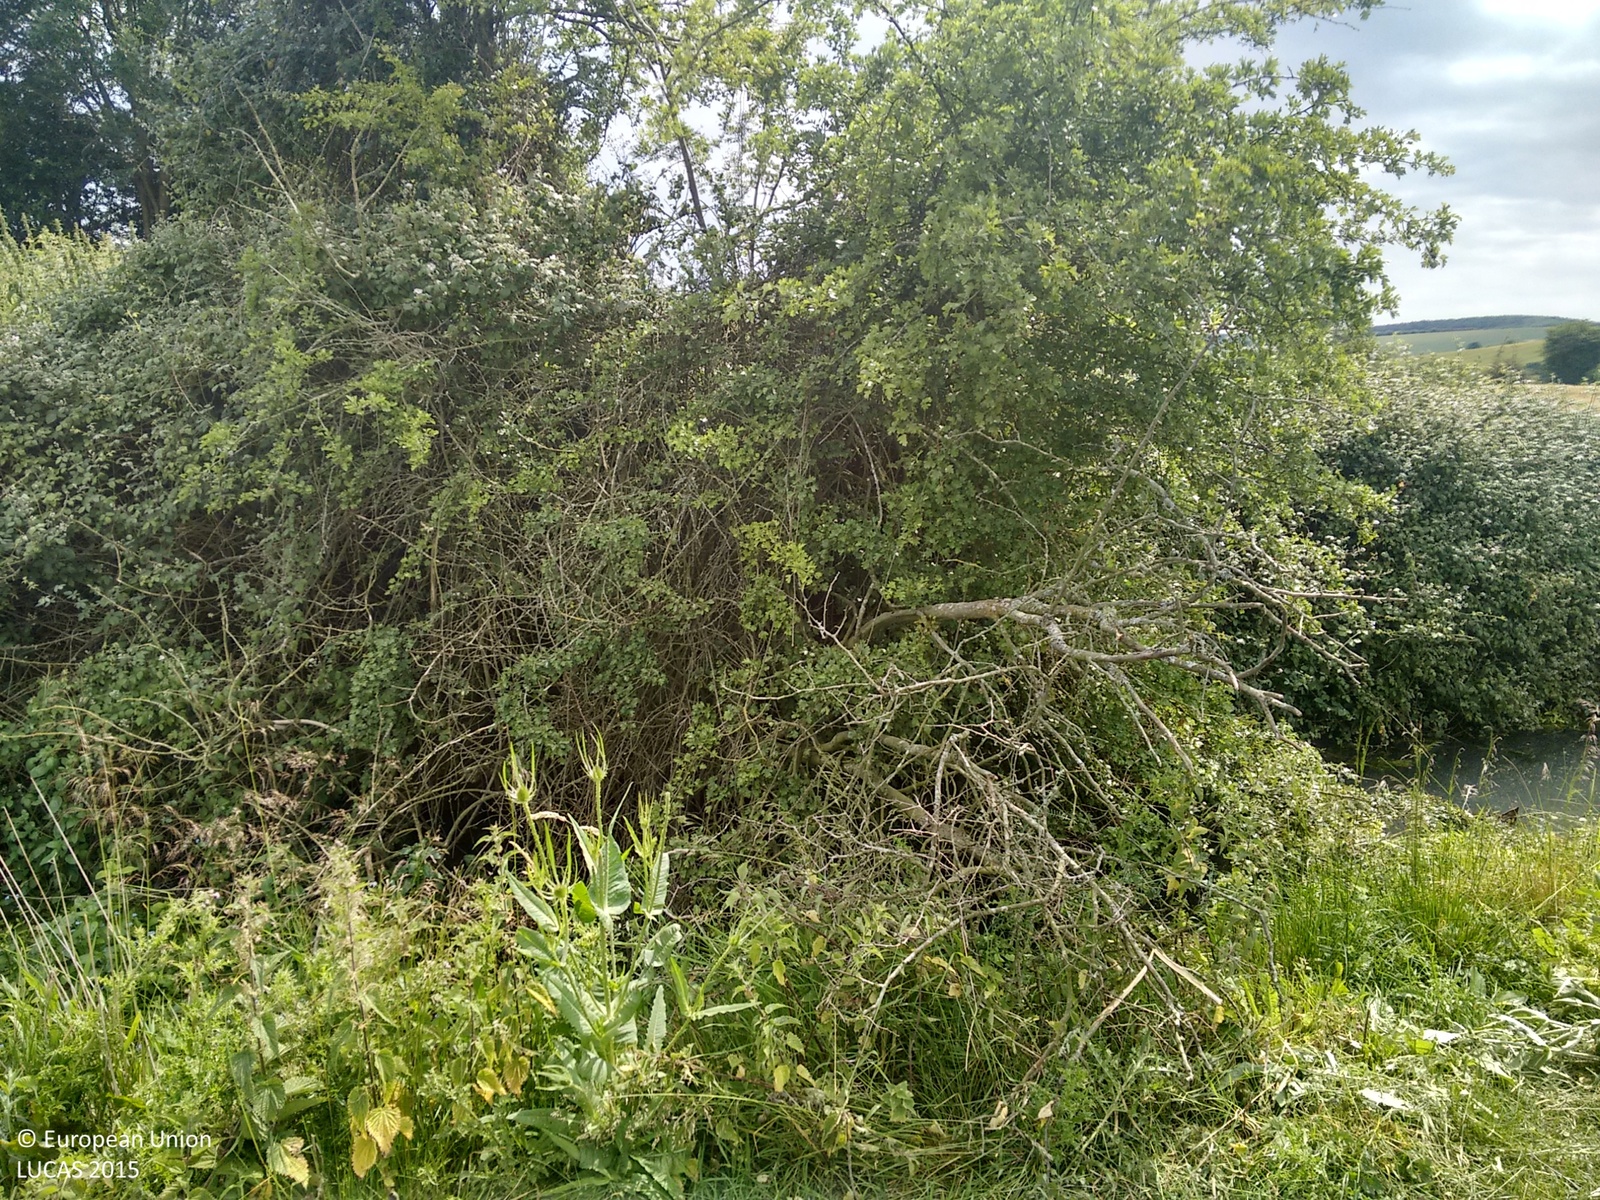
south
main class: Grassland
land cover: Grassland without tree/shrub cover
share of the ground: > 75 %
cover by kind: herbaceous plants 100 %
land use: Agriculture (excluding fallow land and kitchen gardens)
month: July
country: GB
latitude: 50.9086
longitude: -0.5487
